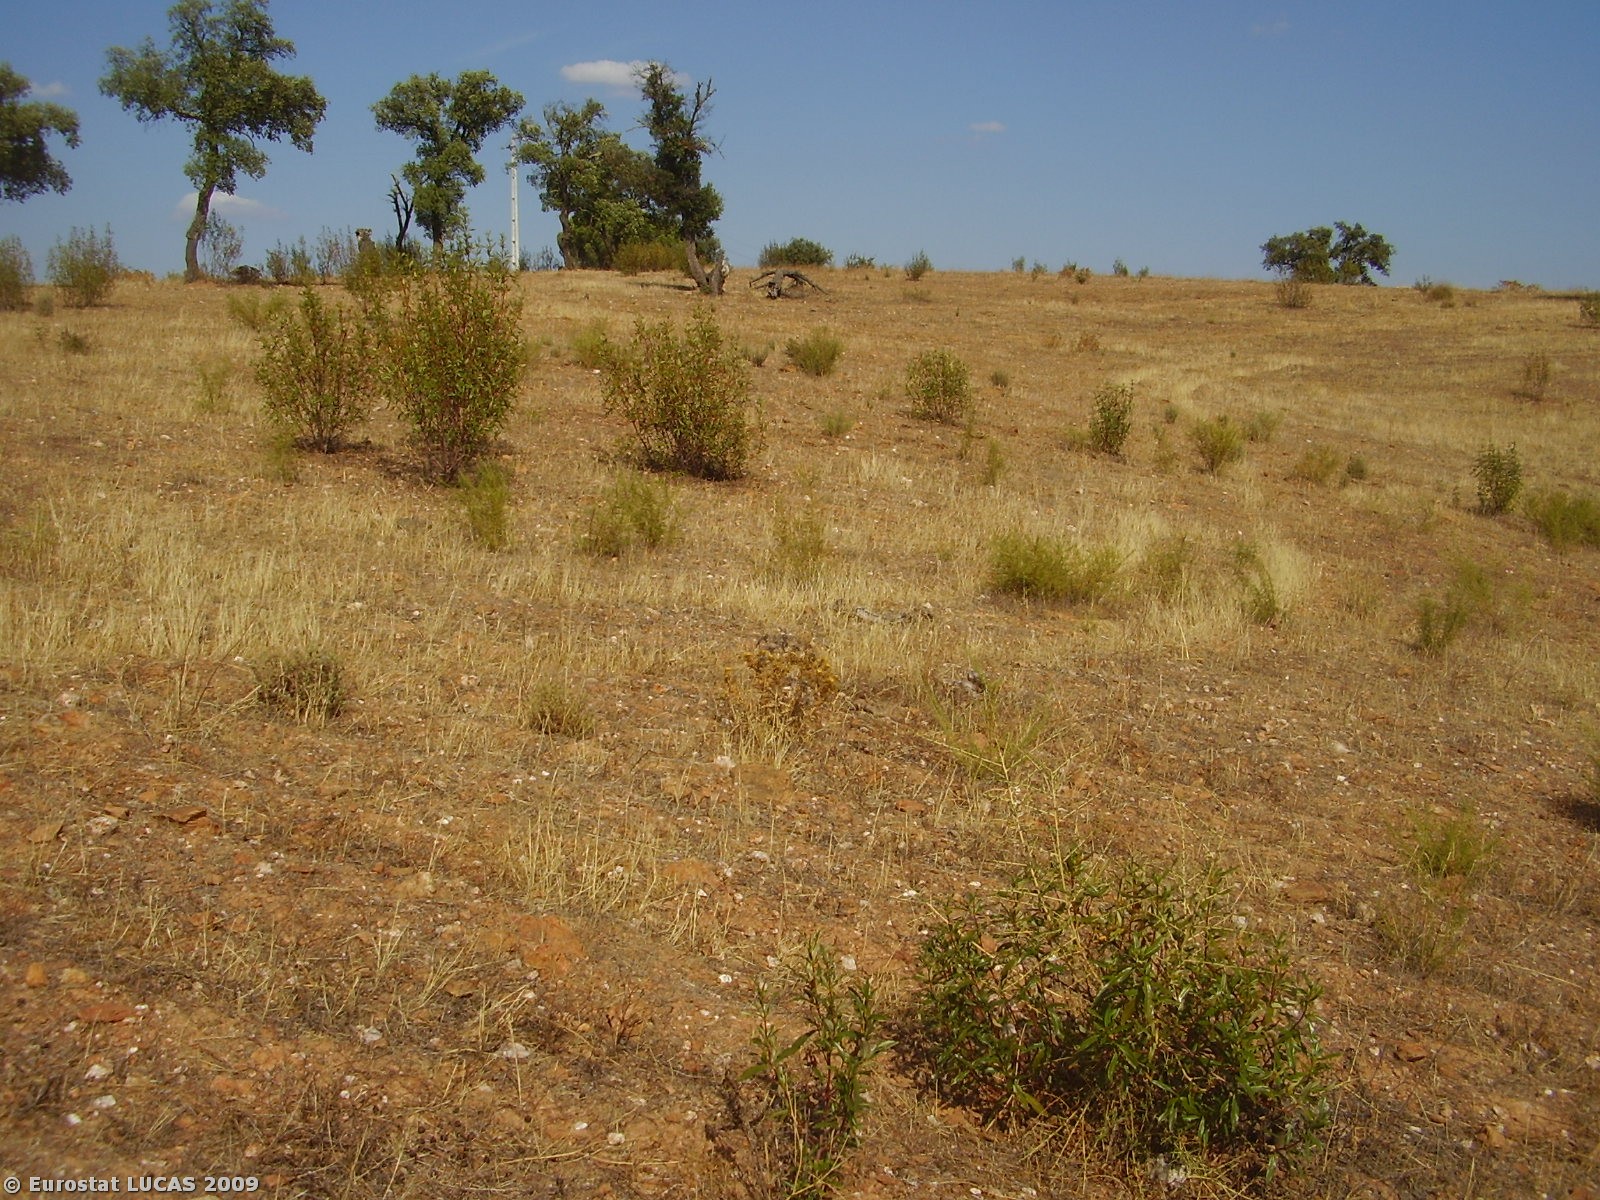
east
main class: Grassland
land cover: Grassland without tree/shrub cover
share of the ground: > 75 %
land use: Fallow land
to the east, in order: Grassland without tree/shrub cover; Grassland with sparse tree/shrub cover; Tracks; Grassland with sparse tree/shrub cover; Tracks; Grassland with sparse tree/shrub cover; Electric lines; Grassland with sparse tree/shrub cover
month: August
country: PT
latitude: 38.2842
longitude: -7.6450
